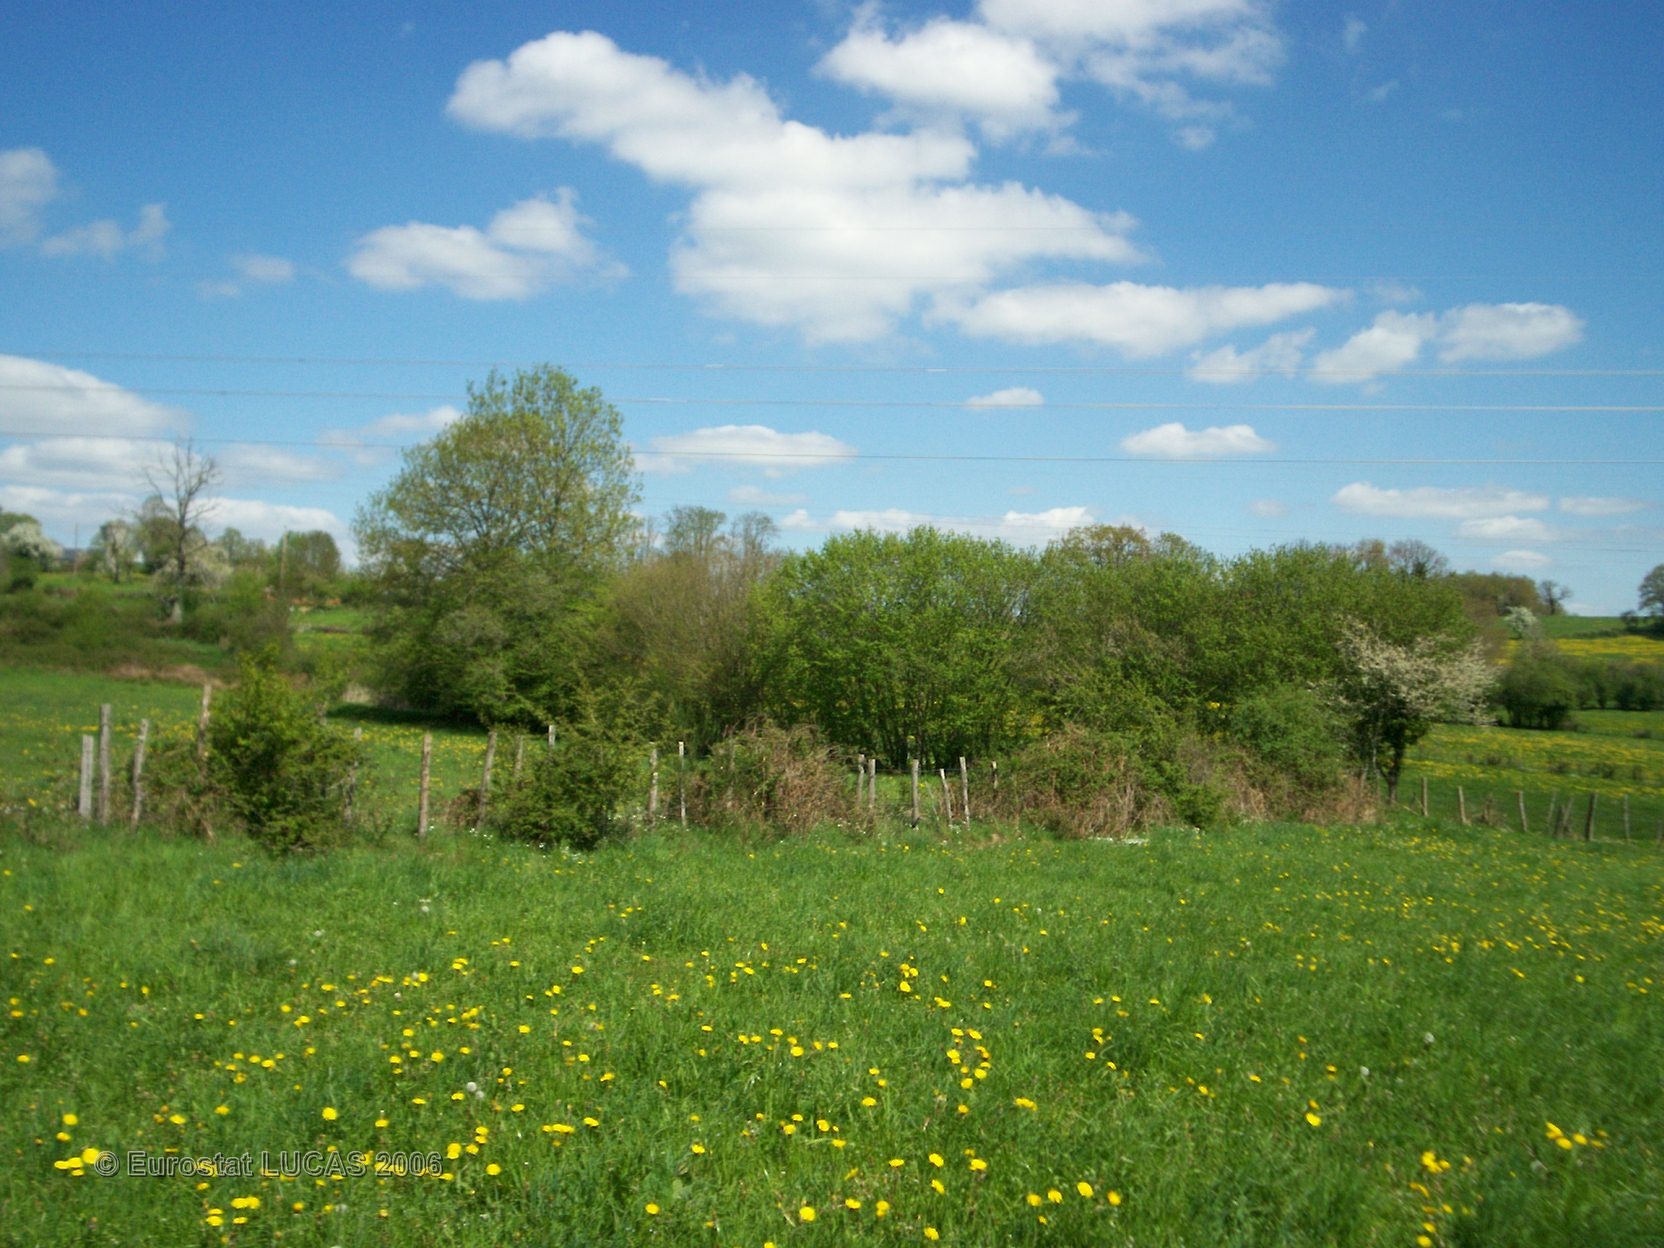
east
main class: Grassland
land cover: Grassland without tree/shrub cover
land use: Agriculture (excluding fallow land and kitchen gardens)
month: April
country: FR
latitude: 46.2239
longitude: 1.6553
